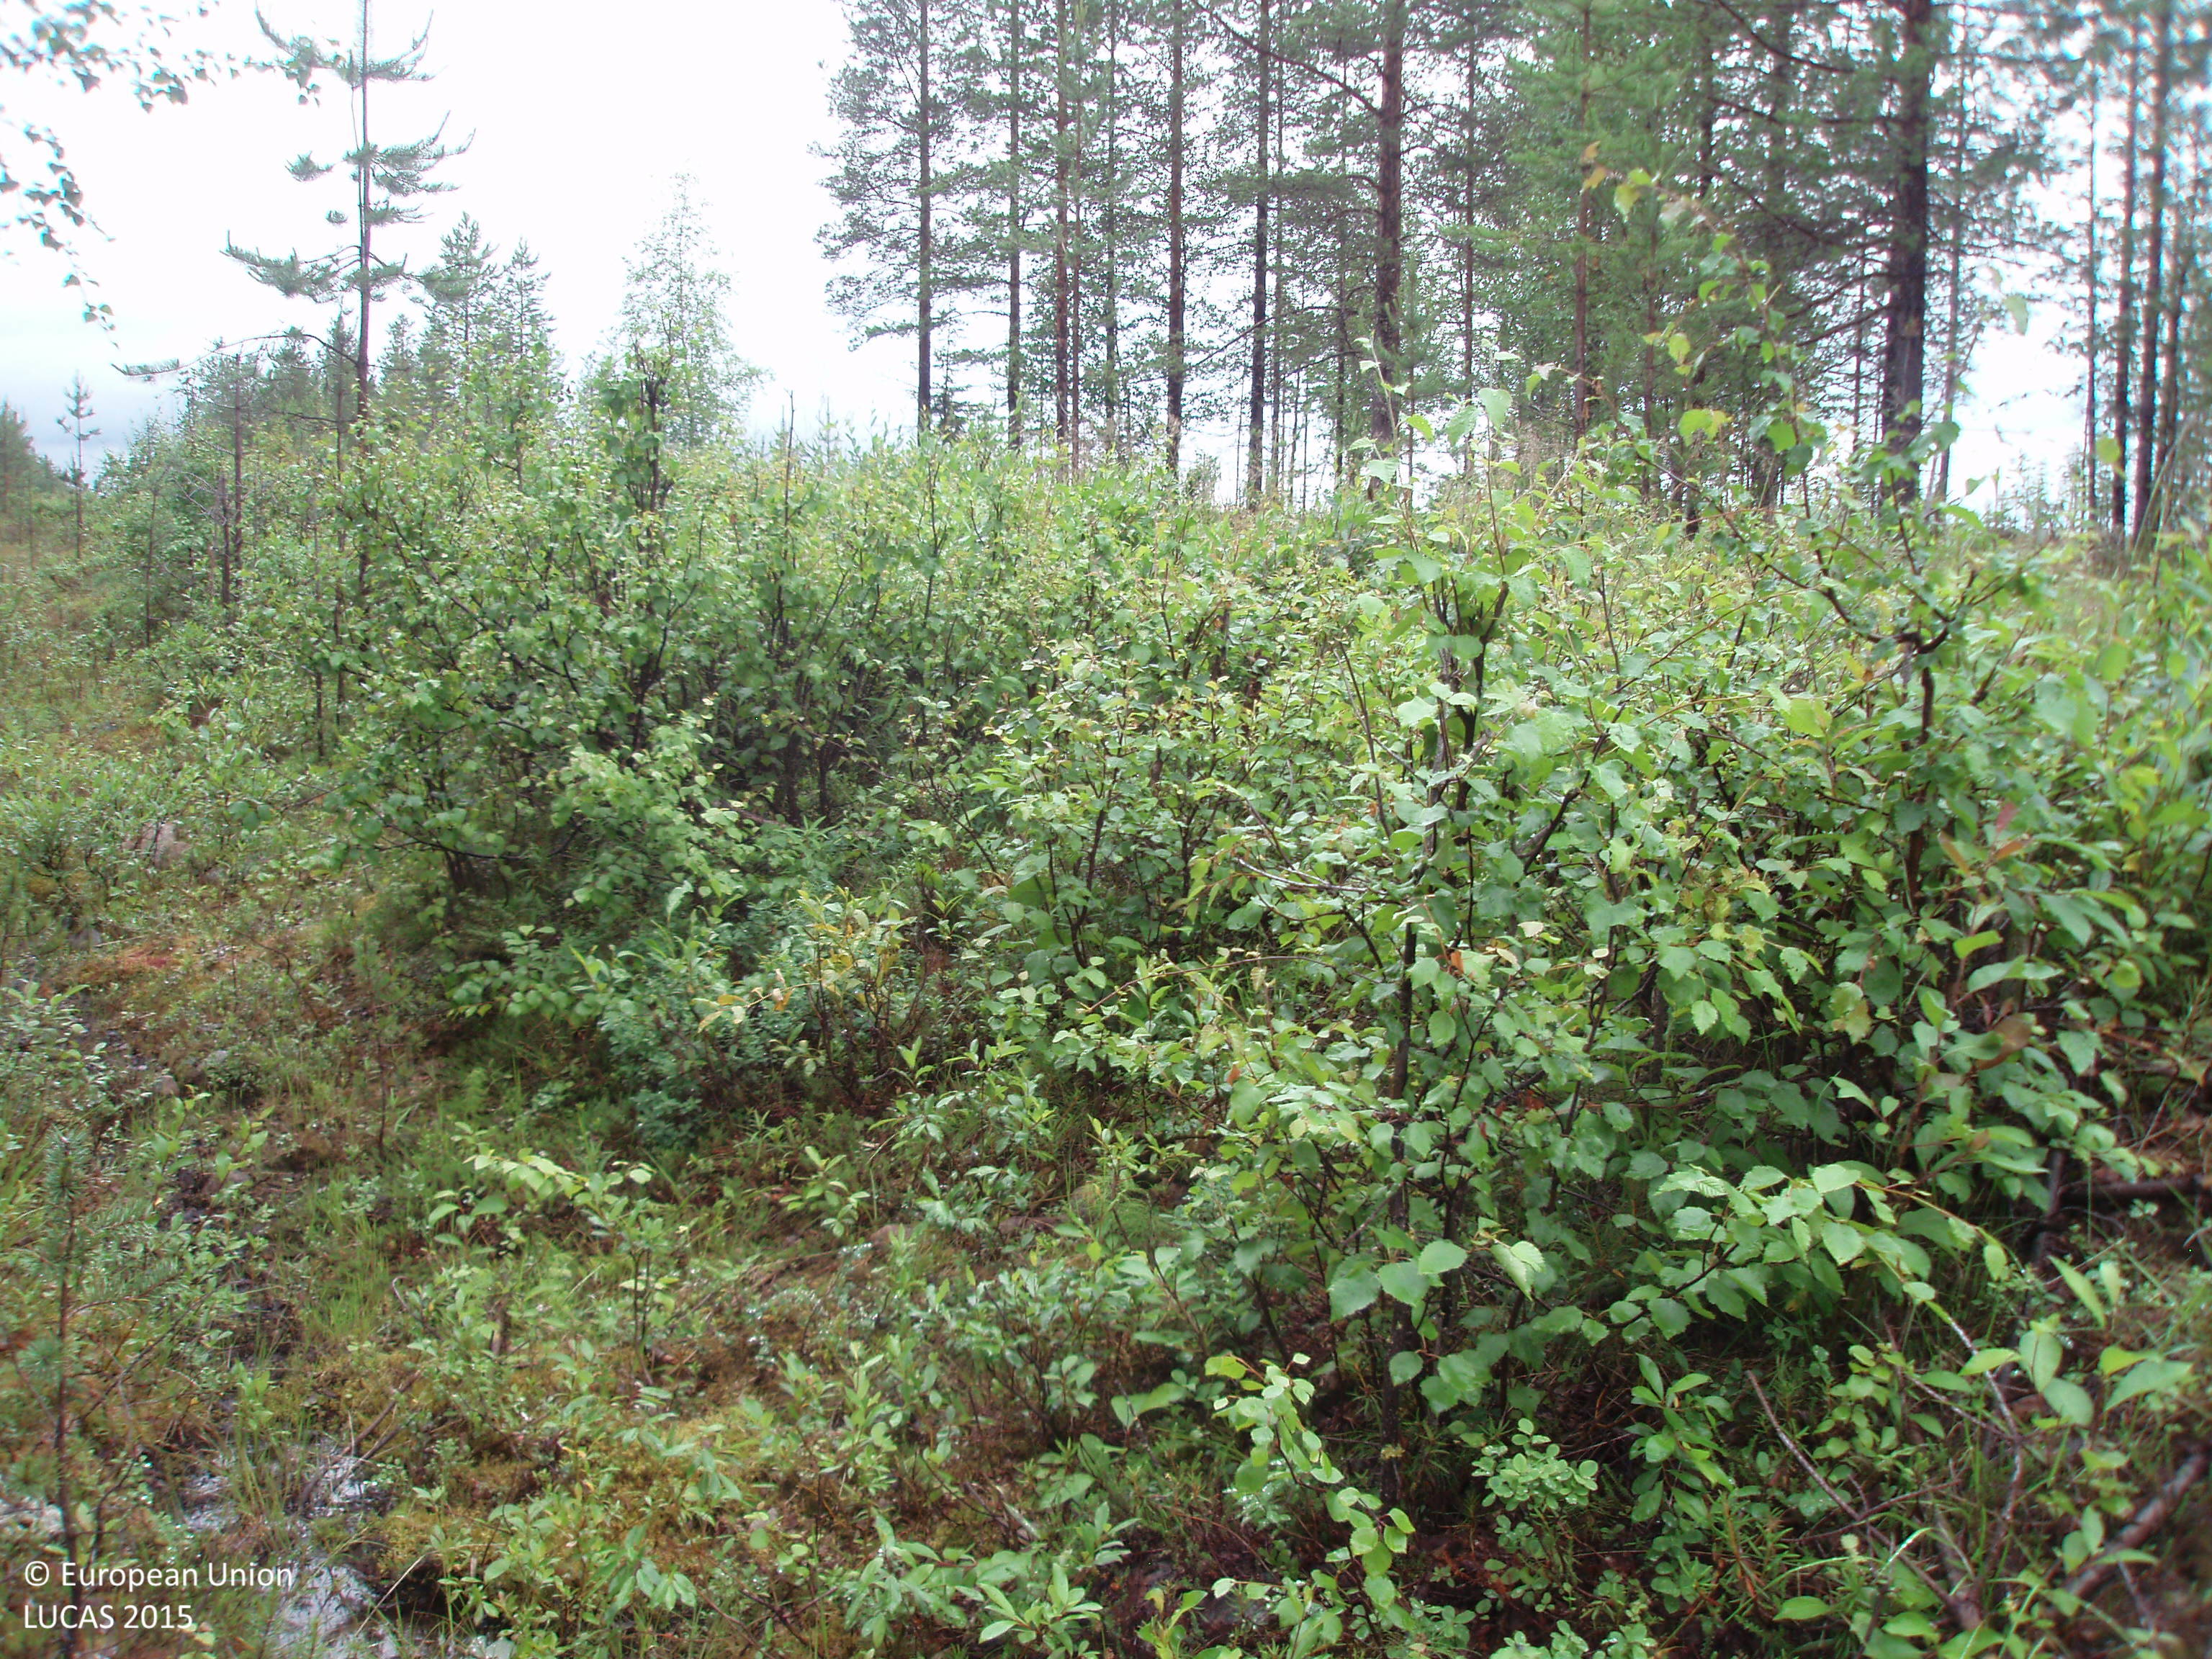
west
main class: Woodland
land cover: Pine dominated coniferous woodland
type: boreal forest
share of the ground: 50 - 75 %
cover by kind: shrubs 50 %, coniferous forest trees 45 %, broadleaved forest trees 5 %
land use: Forestry
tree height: > 5 m
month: July
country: FI
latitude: 66.6405
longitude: 28.0050
